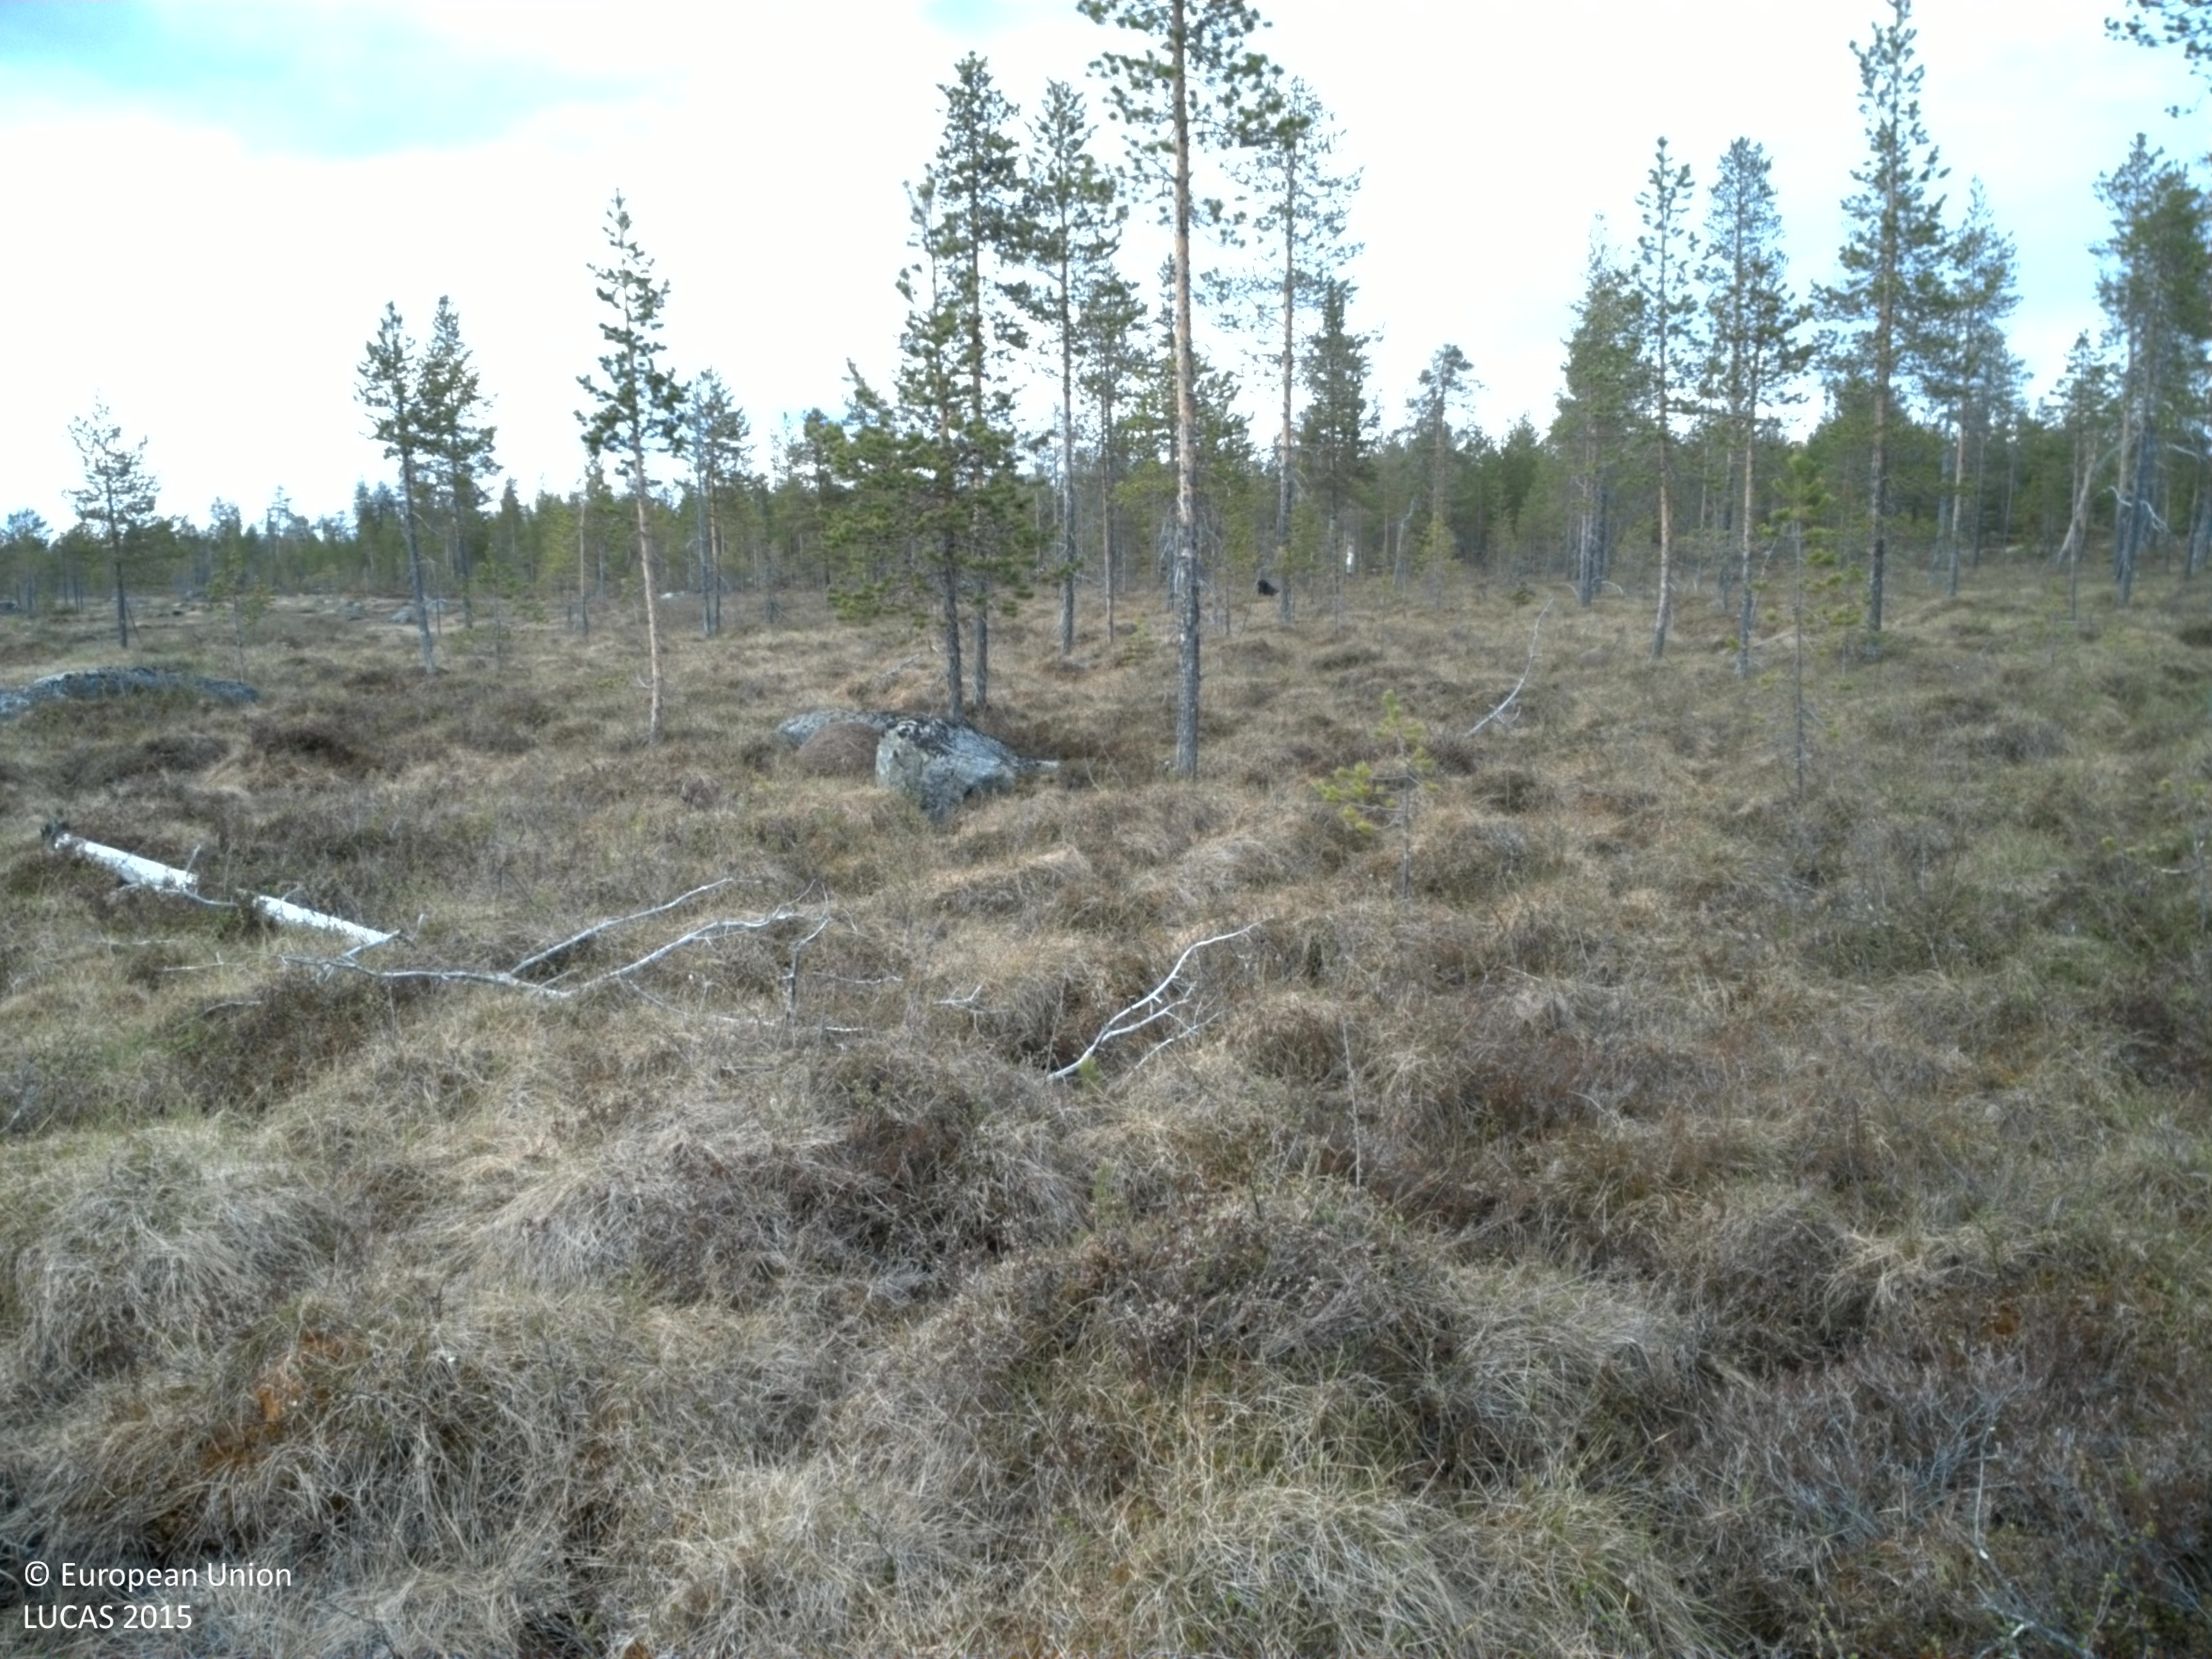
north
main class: Shrubland
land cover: Shrubland without tree cover
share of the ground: 25 - 50 %
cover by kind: herbaceous plants 60 %, shrubs 40 %
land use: Semi-natural and natural areas not in use
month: June
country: SE
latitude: 66.2526
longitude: 18.6992
